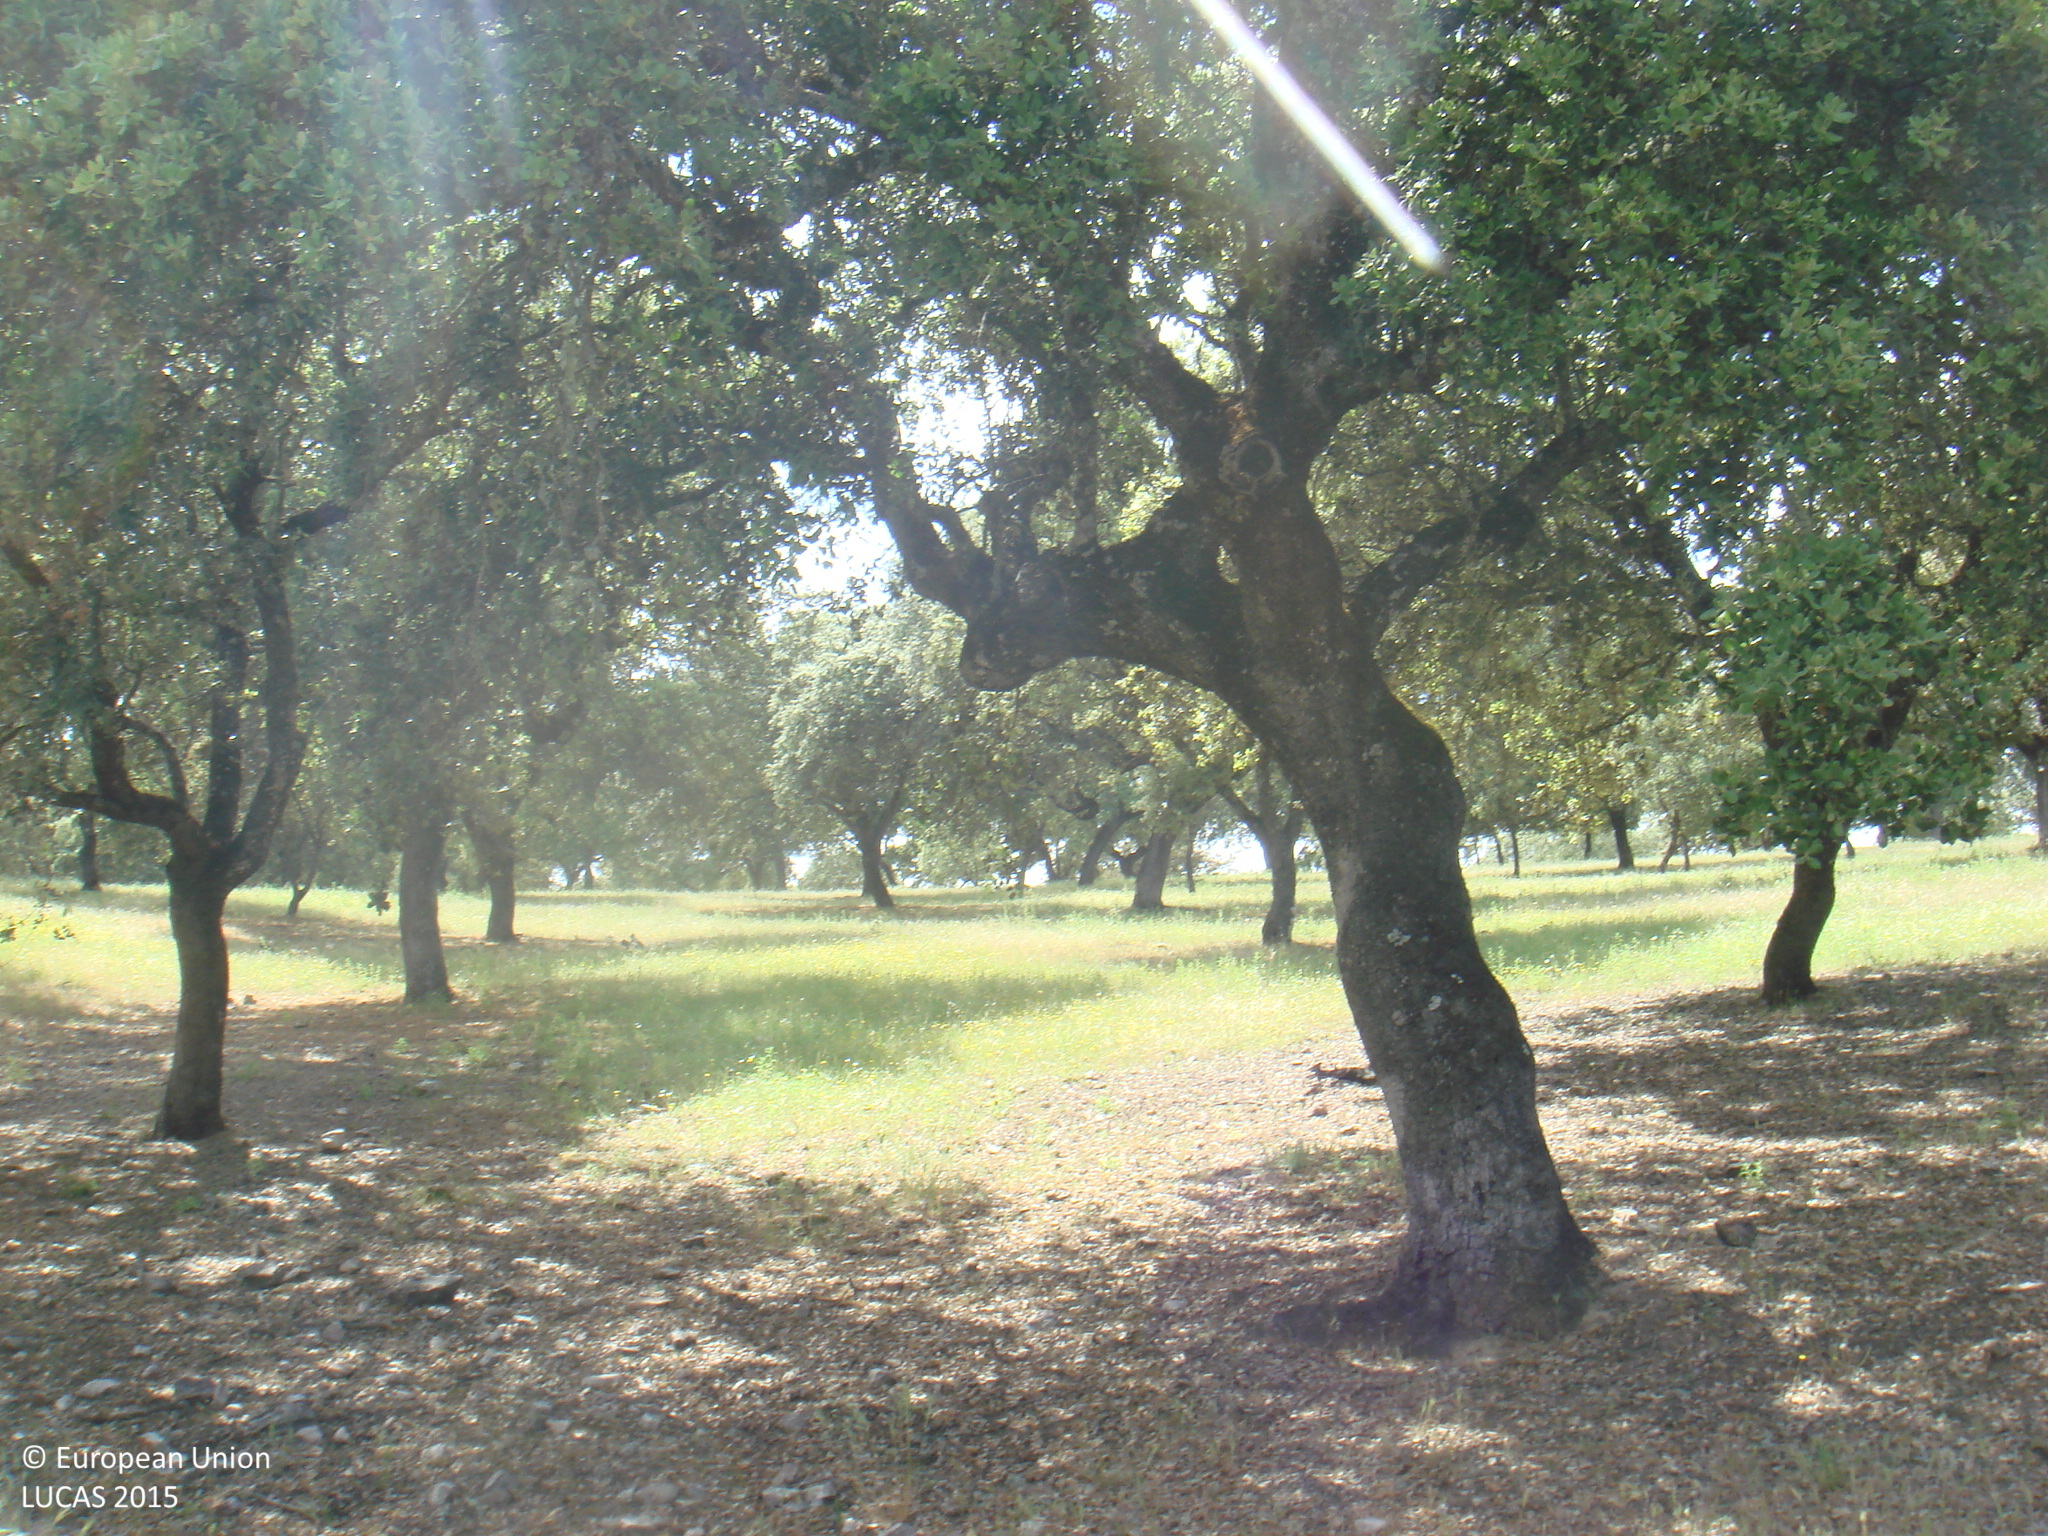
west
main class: Woodland
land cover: Broadleaved woodland
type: broadleaved evergreen forest
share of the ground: 25 - 50 %
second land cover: Spontaneously vegetated surfaces
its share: > 75 %
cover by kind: herbaceous plants 60 %, broadleaved forest trees 40 %
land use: Forestry
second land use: Agriculture (excluding fallow land and kitchen gardens)
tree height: > 5 m
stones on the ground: < 10 %
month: May
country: ES
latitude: 38.3399
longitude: -4.3749
